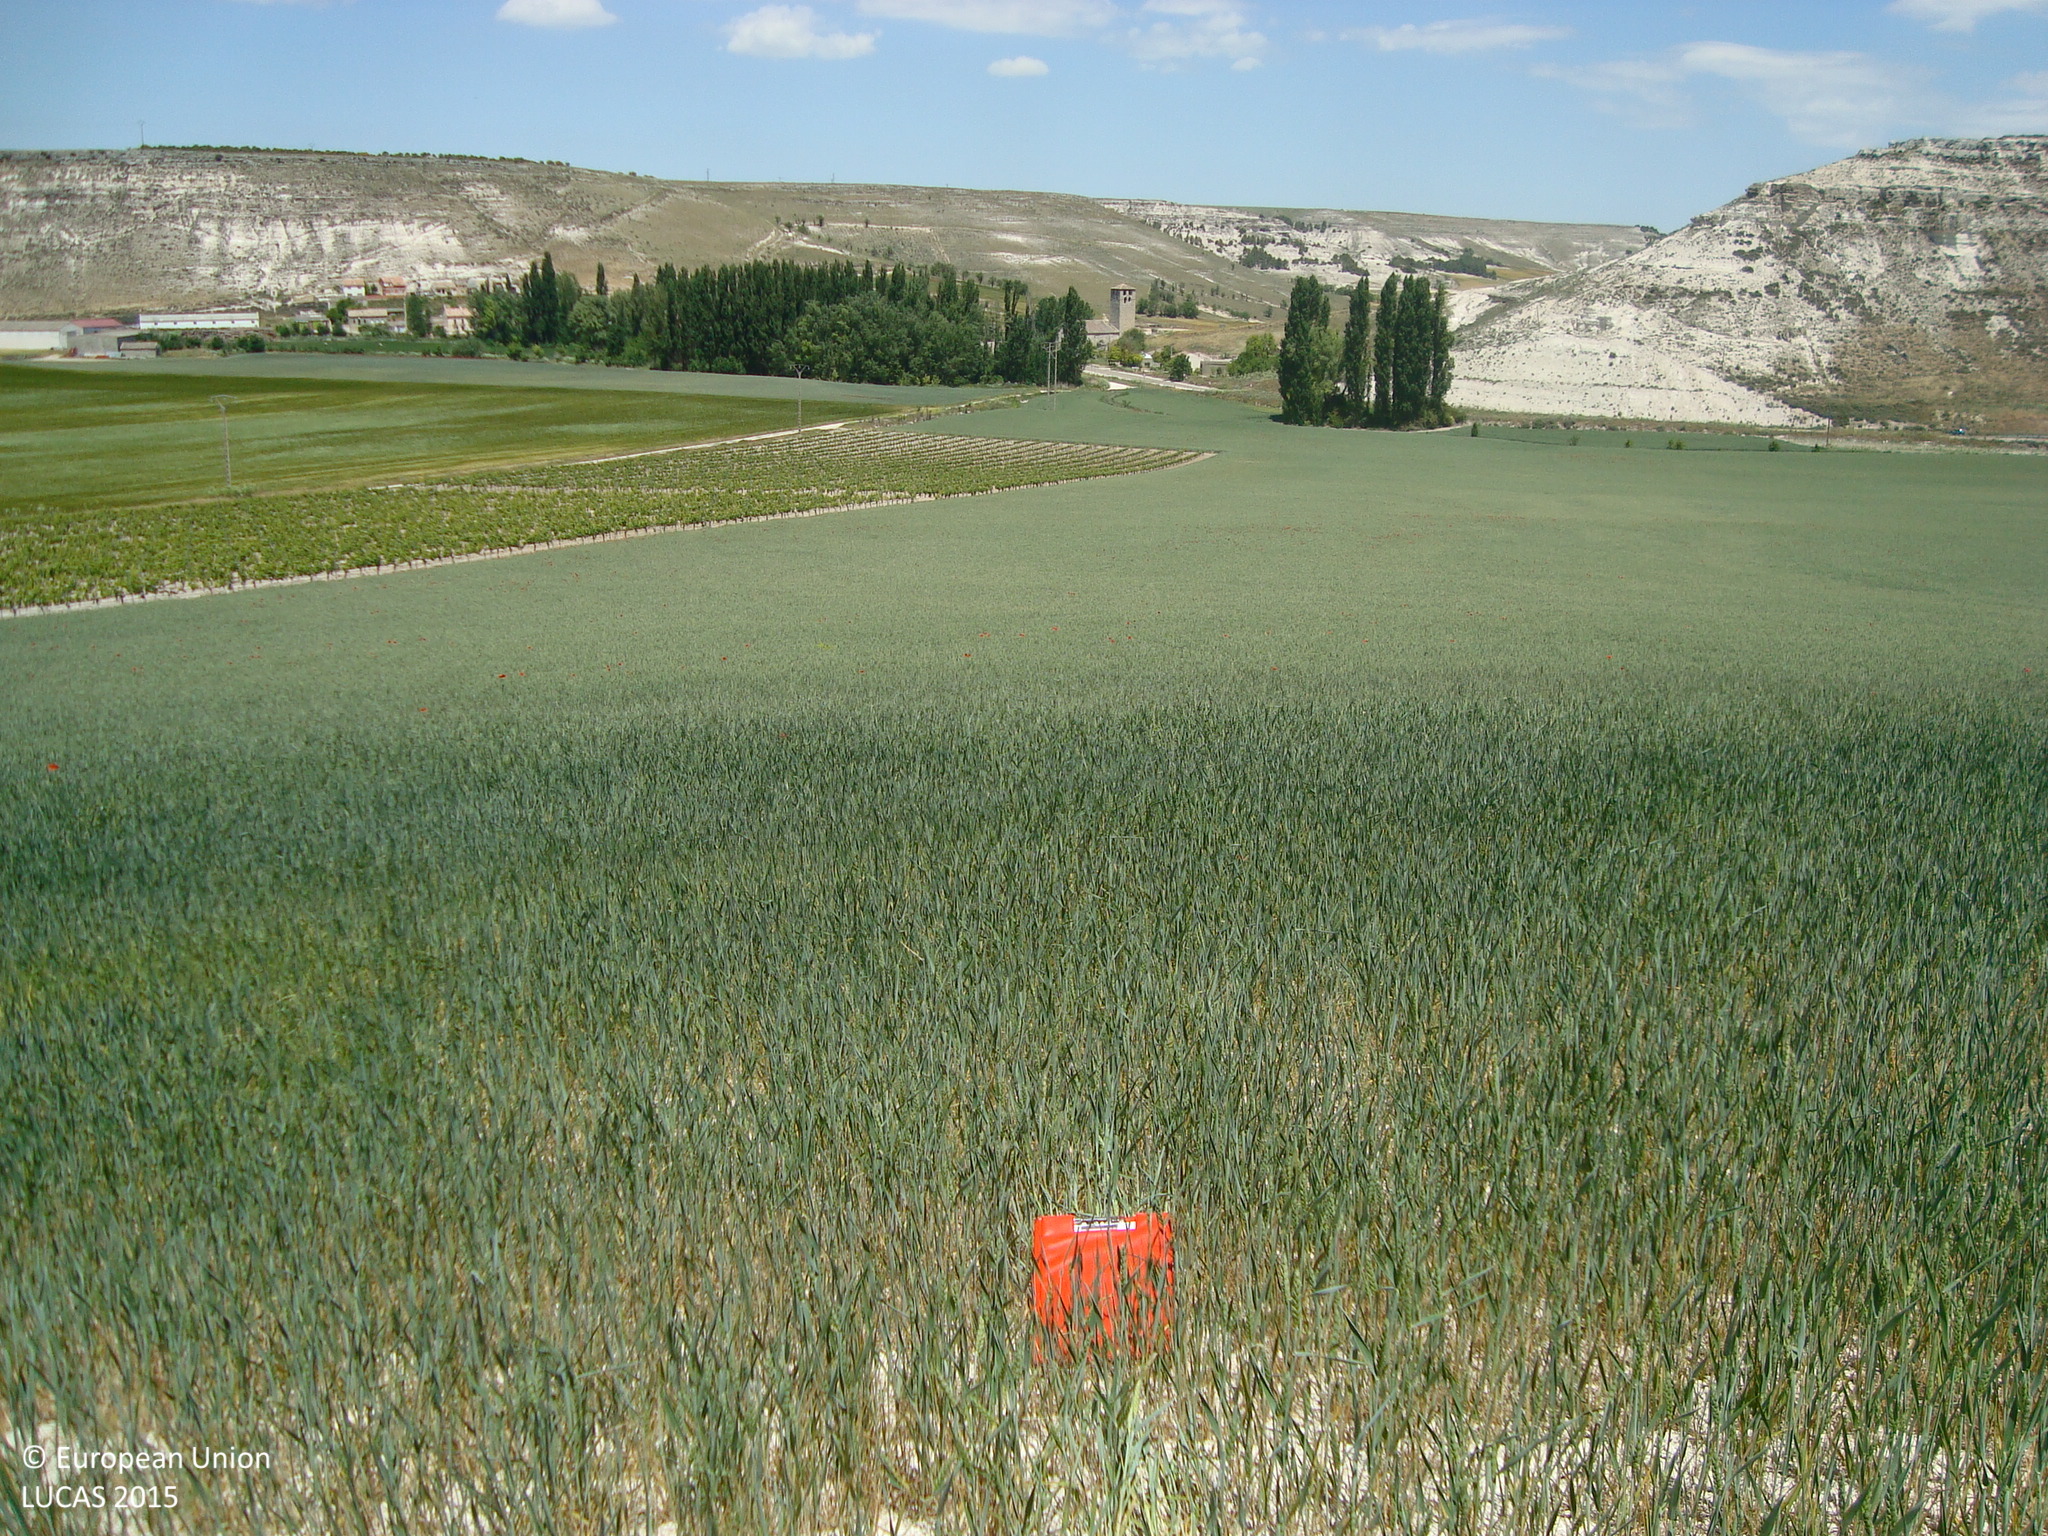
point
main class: Cropland
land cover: Common wheat
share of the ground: 50 - 75 %
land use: Agriculture (excluding fallow land and kitchen gardens)
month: May
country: ES
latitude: 41.5459
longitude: -4.1440
